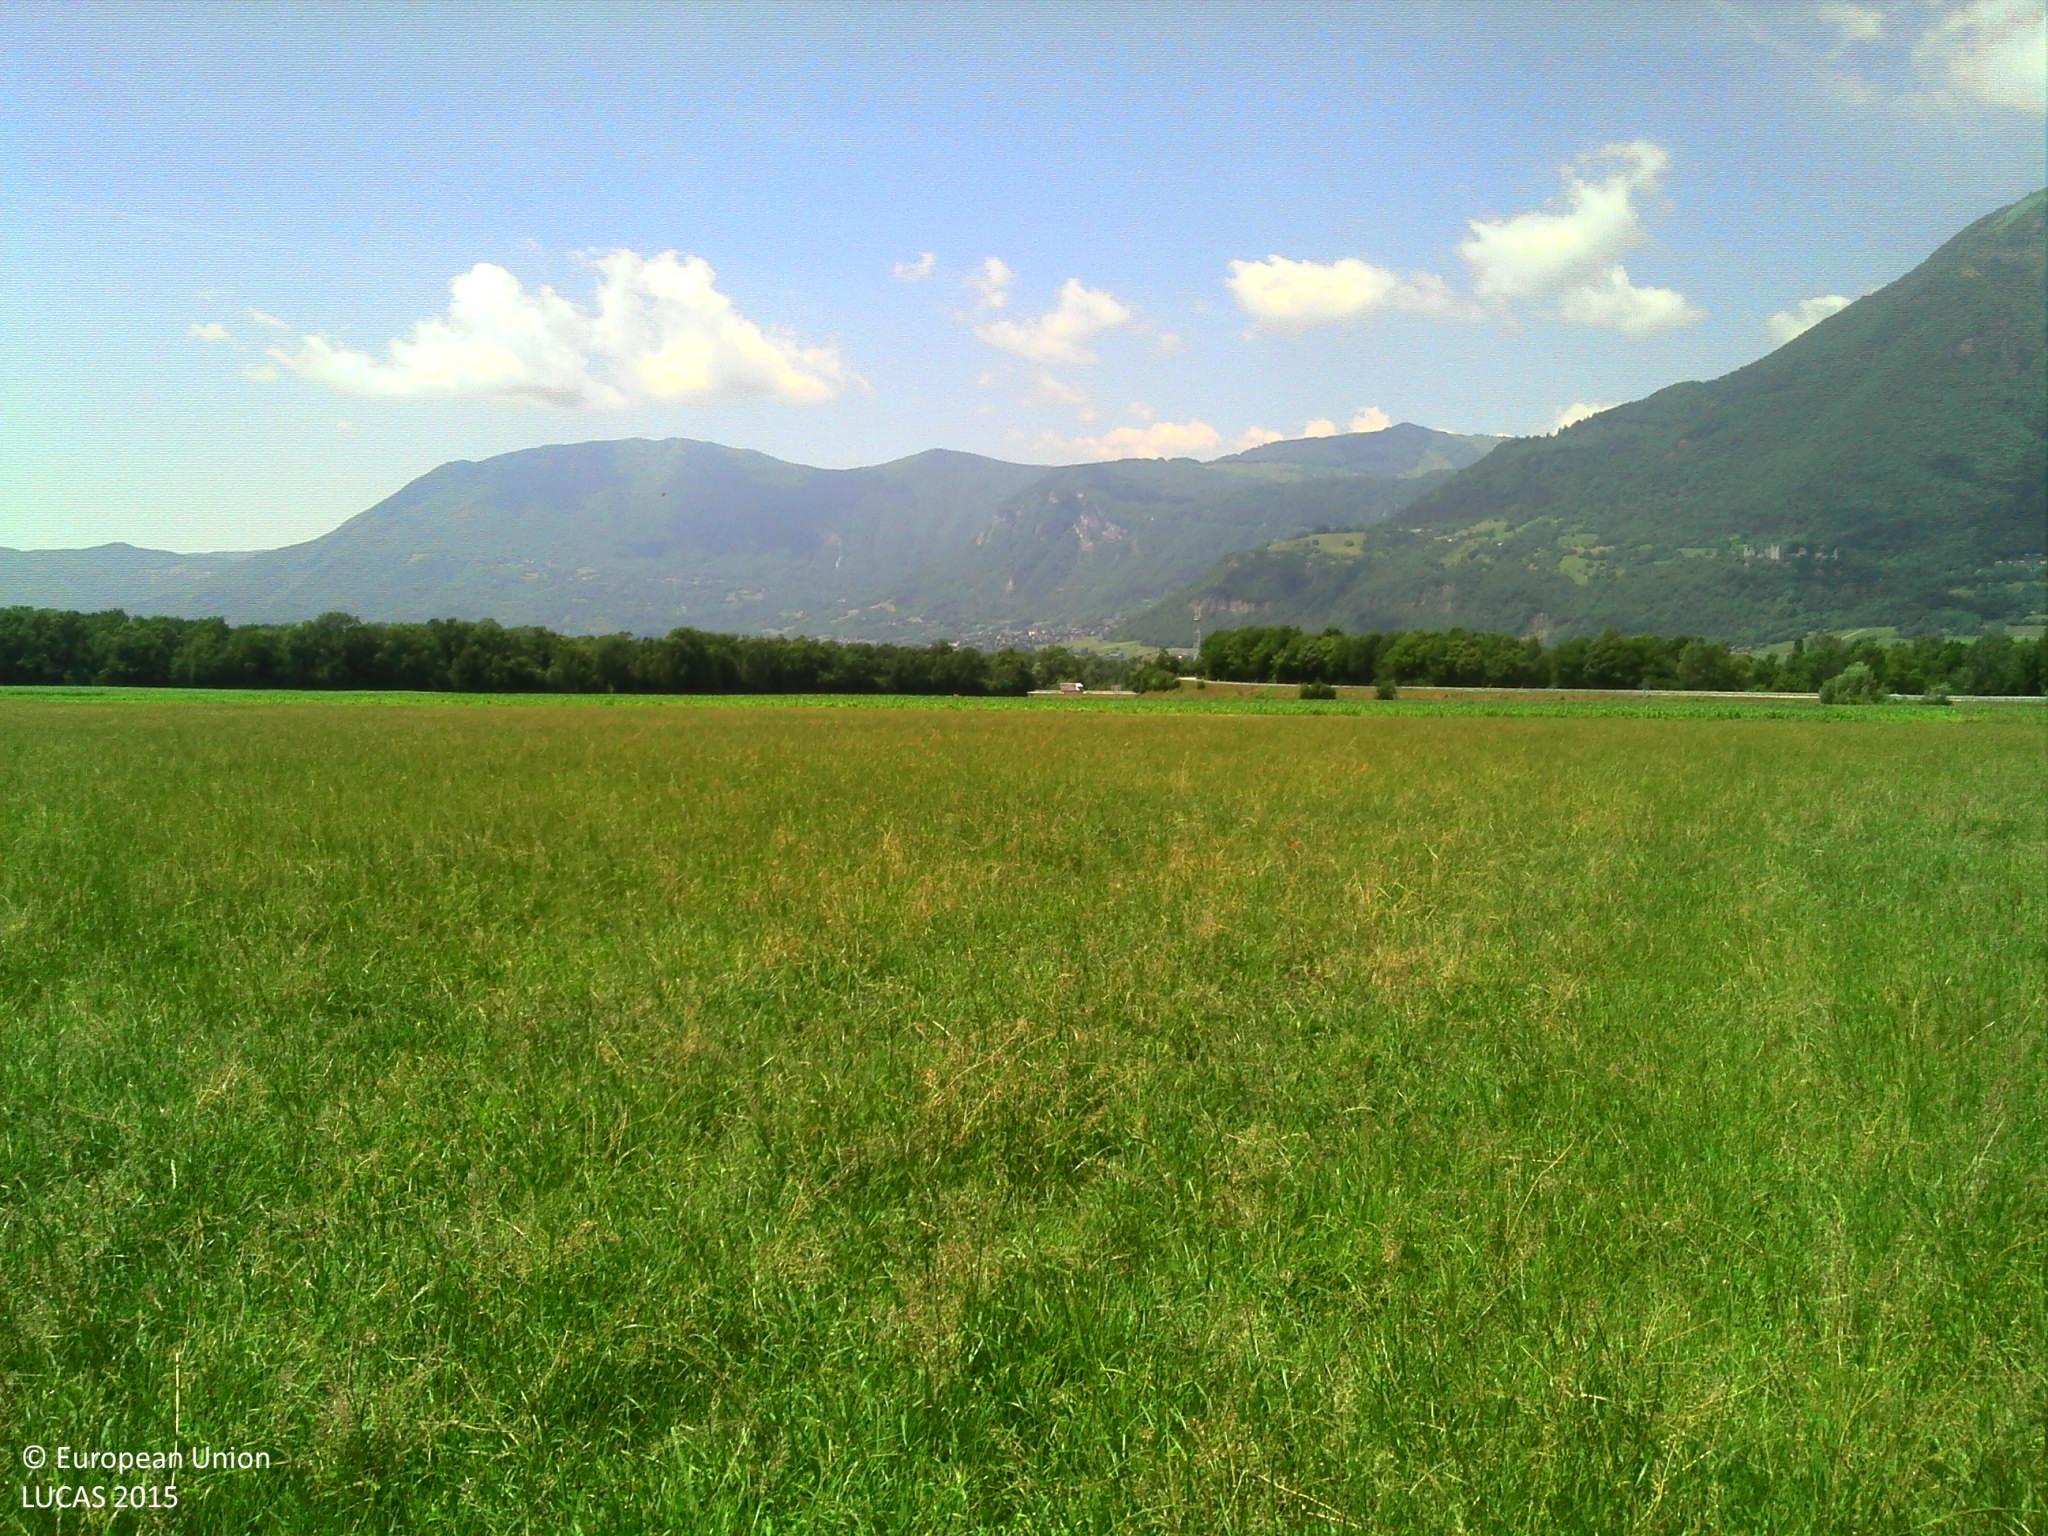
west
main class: Grassland
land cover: Grassland without tree/shrub cover
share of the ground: > 75 %
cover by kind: herbaceous plants 100 %
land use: Agriculture (excluding fallow land and kitchen gardens)
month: June
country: FR
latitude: 45.5632
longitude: 6.2250
